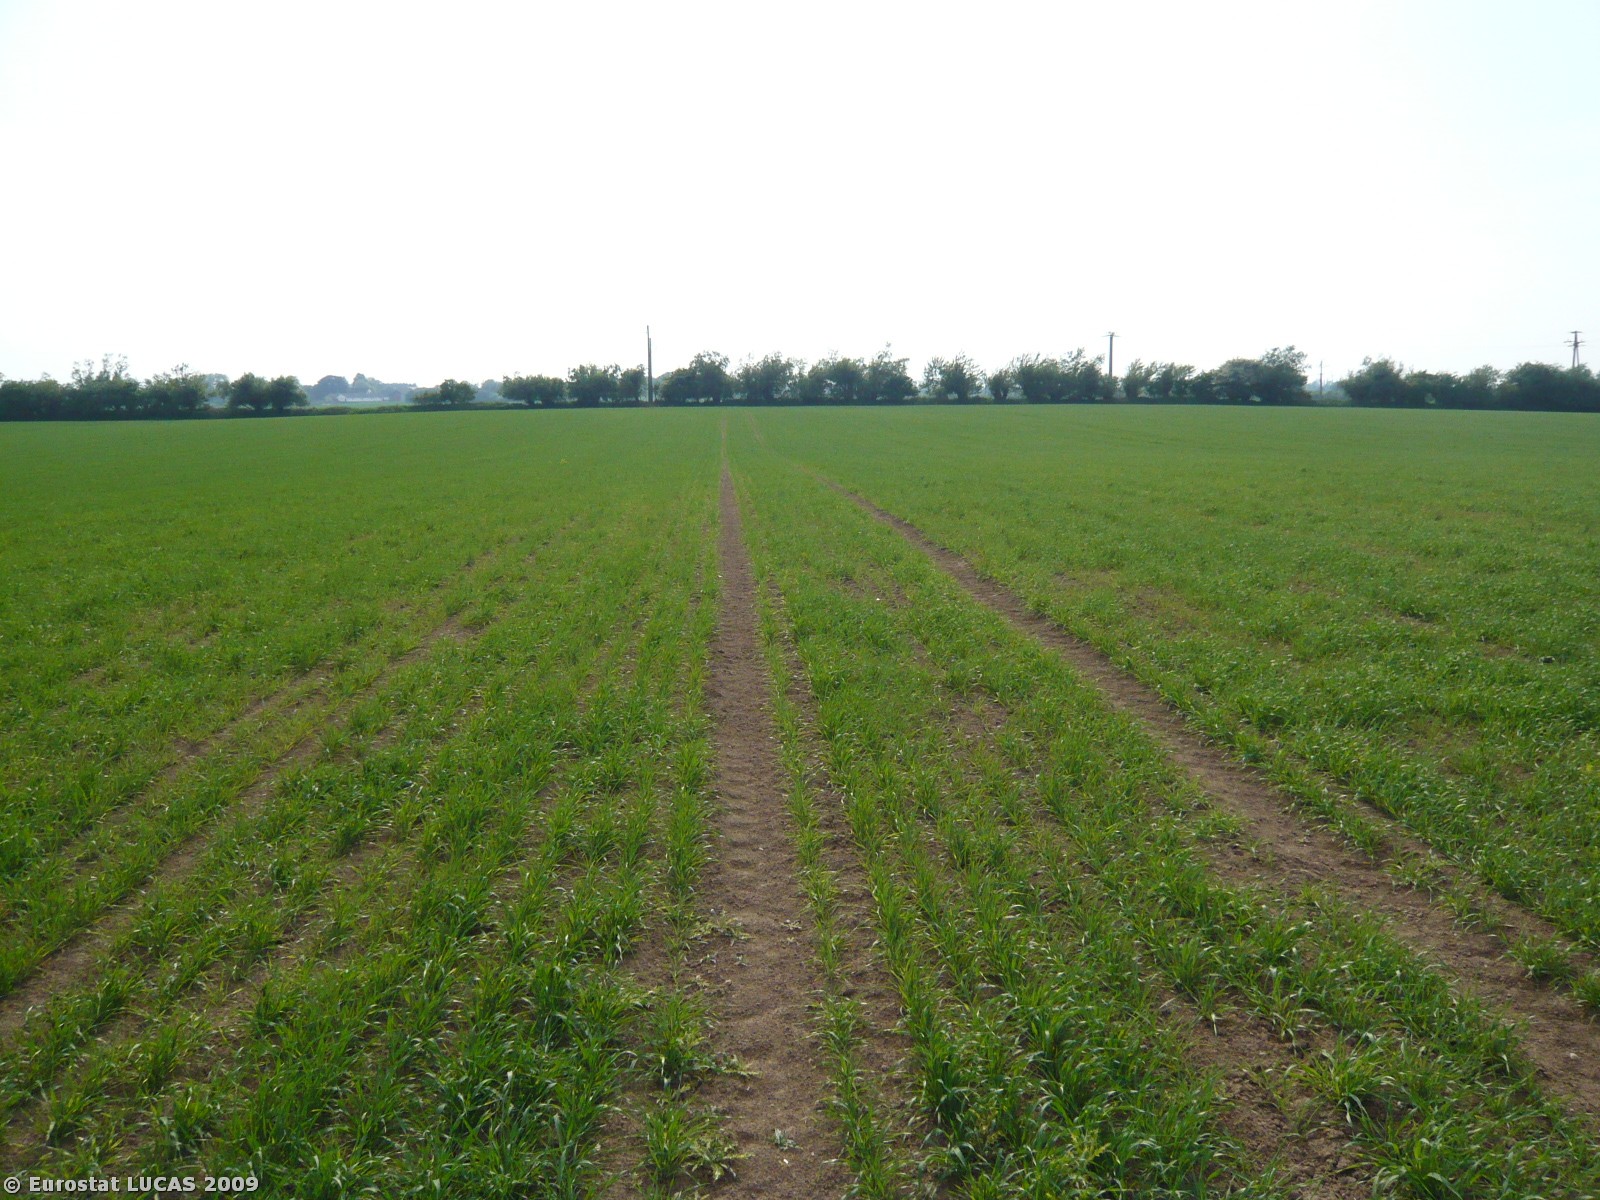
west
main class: Cropland
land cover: Barley
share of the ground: 50 - 75 %
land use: Agriculture (excluding fallow land and kitchen gardens)
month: May
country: DK
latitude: 55.2423
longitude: 11.6501
